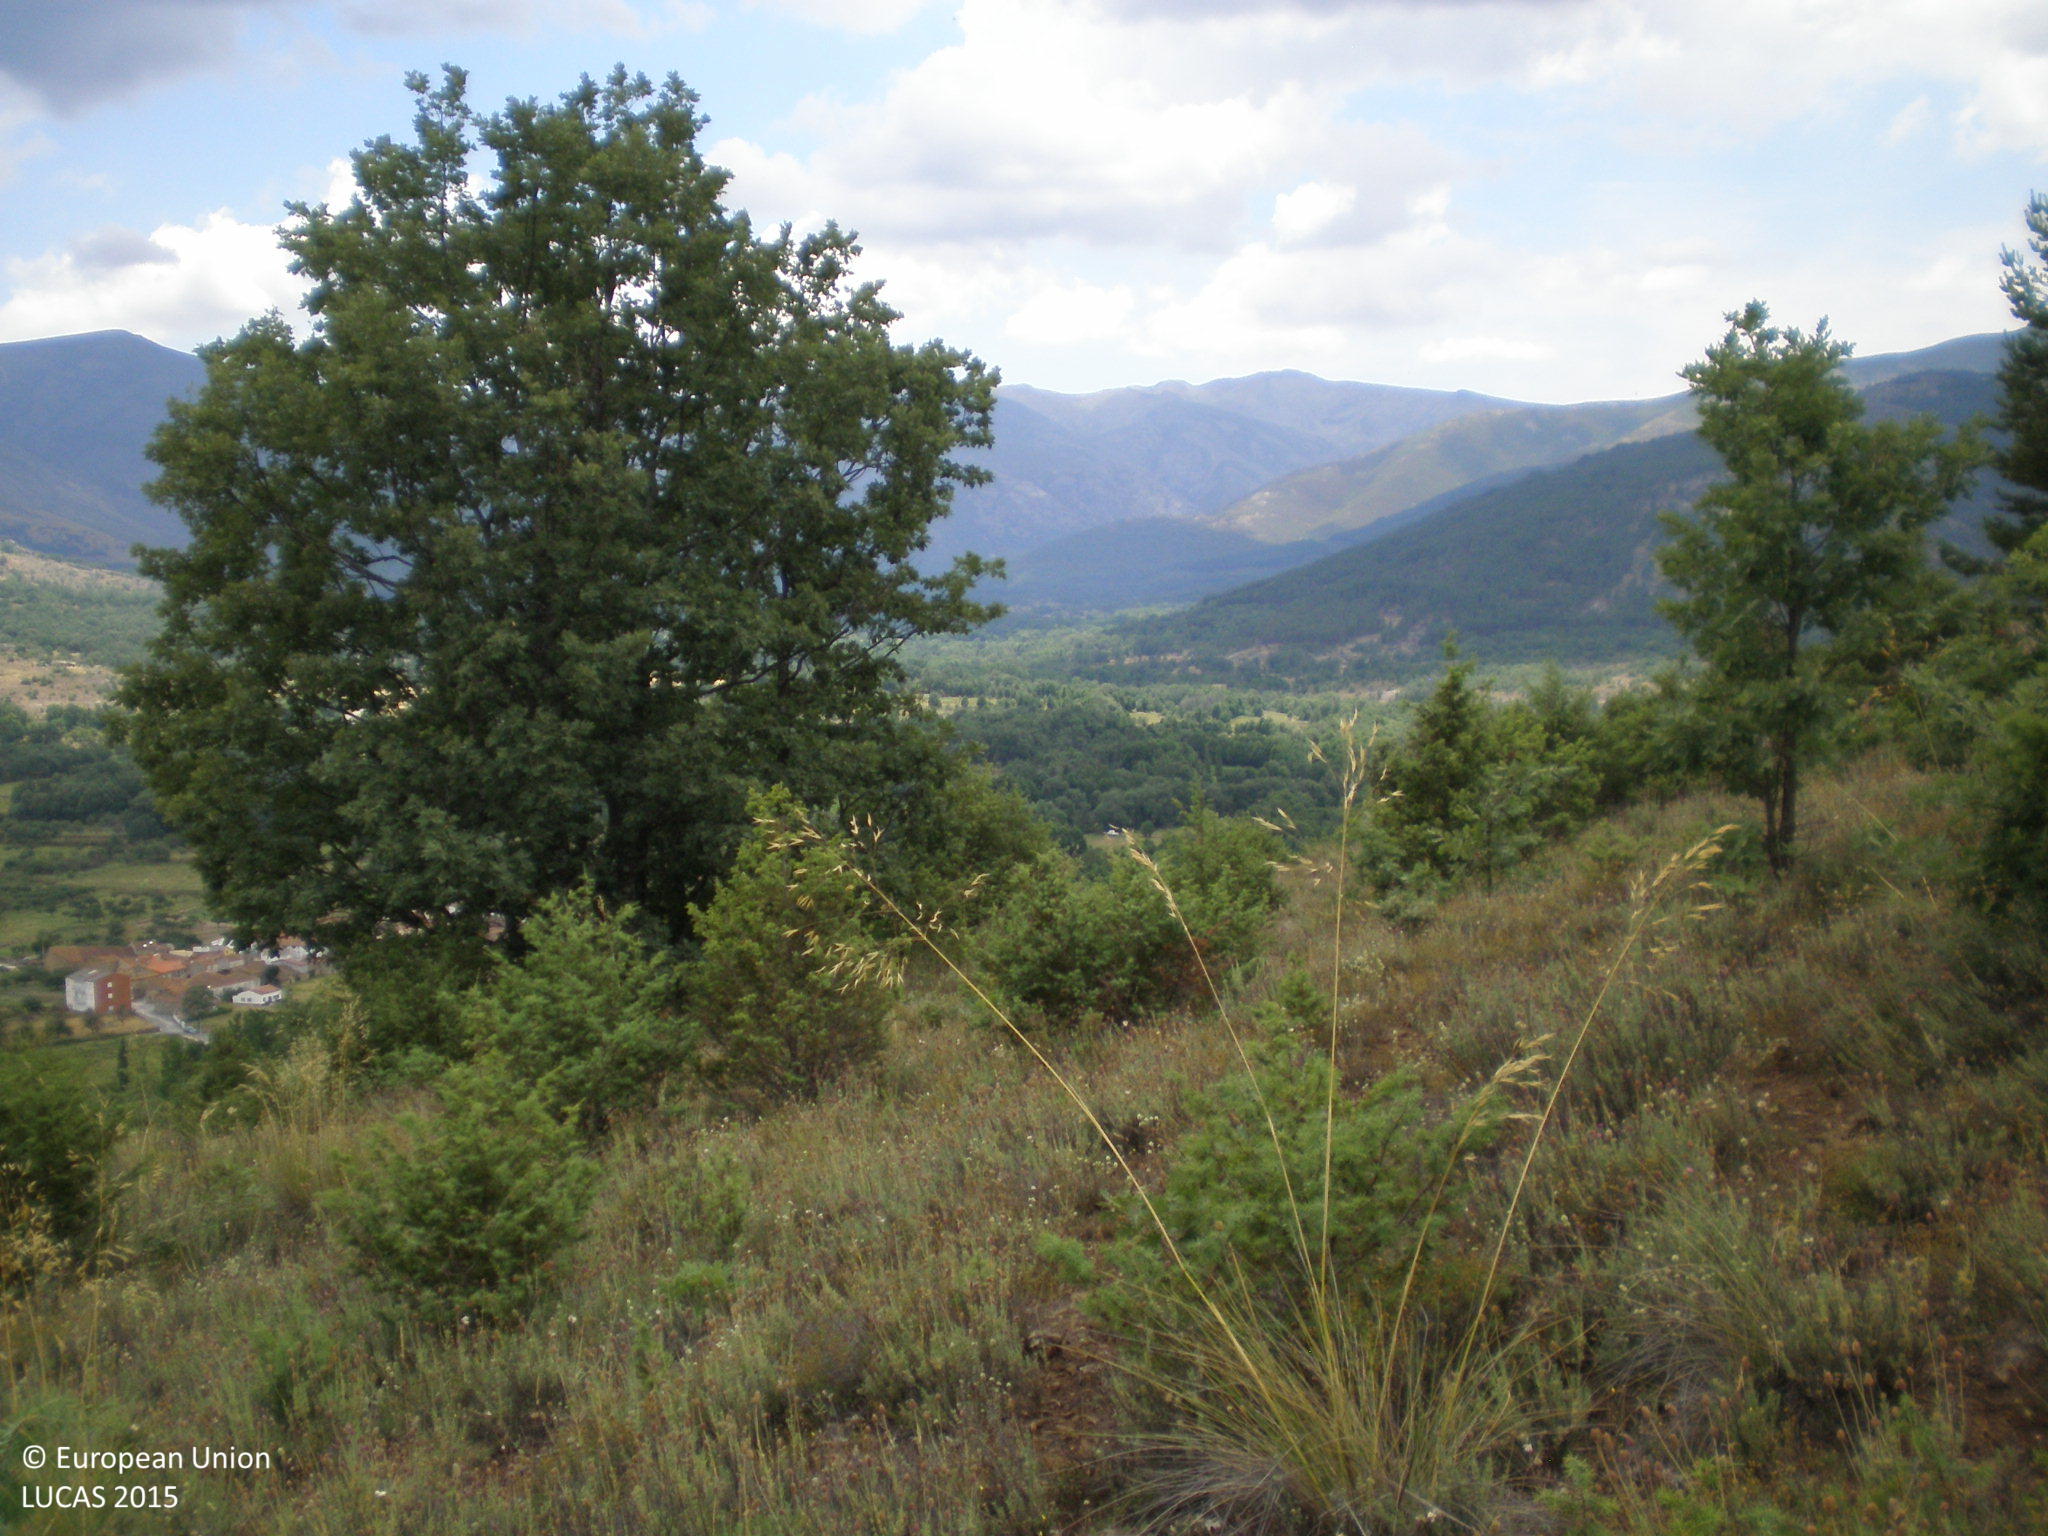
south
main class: Shrubland
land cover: Shrubland without tree cover
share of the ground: > 75 %
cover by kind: shrubs 100 %
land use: Semi-natural and natural areas not in use
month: June
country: ES
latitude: 40.3114
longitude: -5.5147
